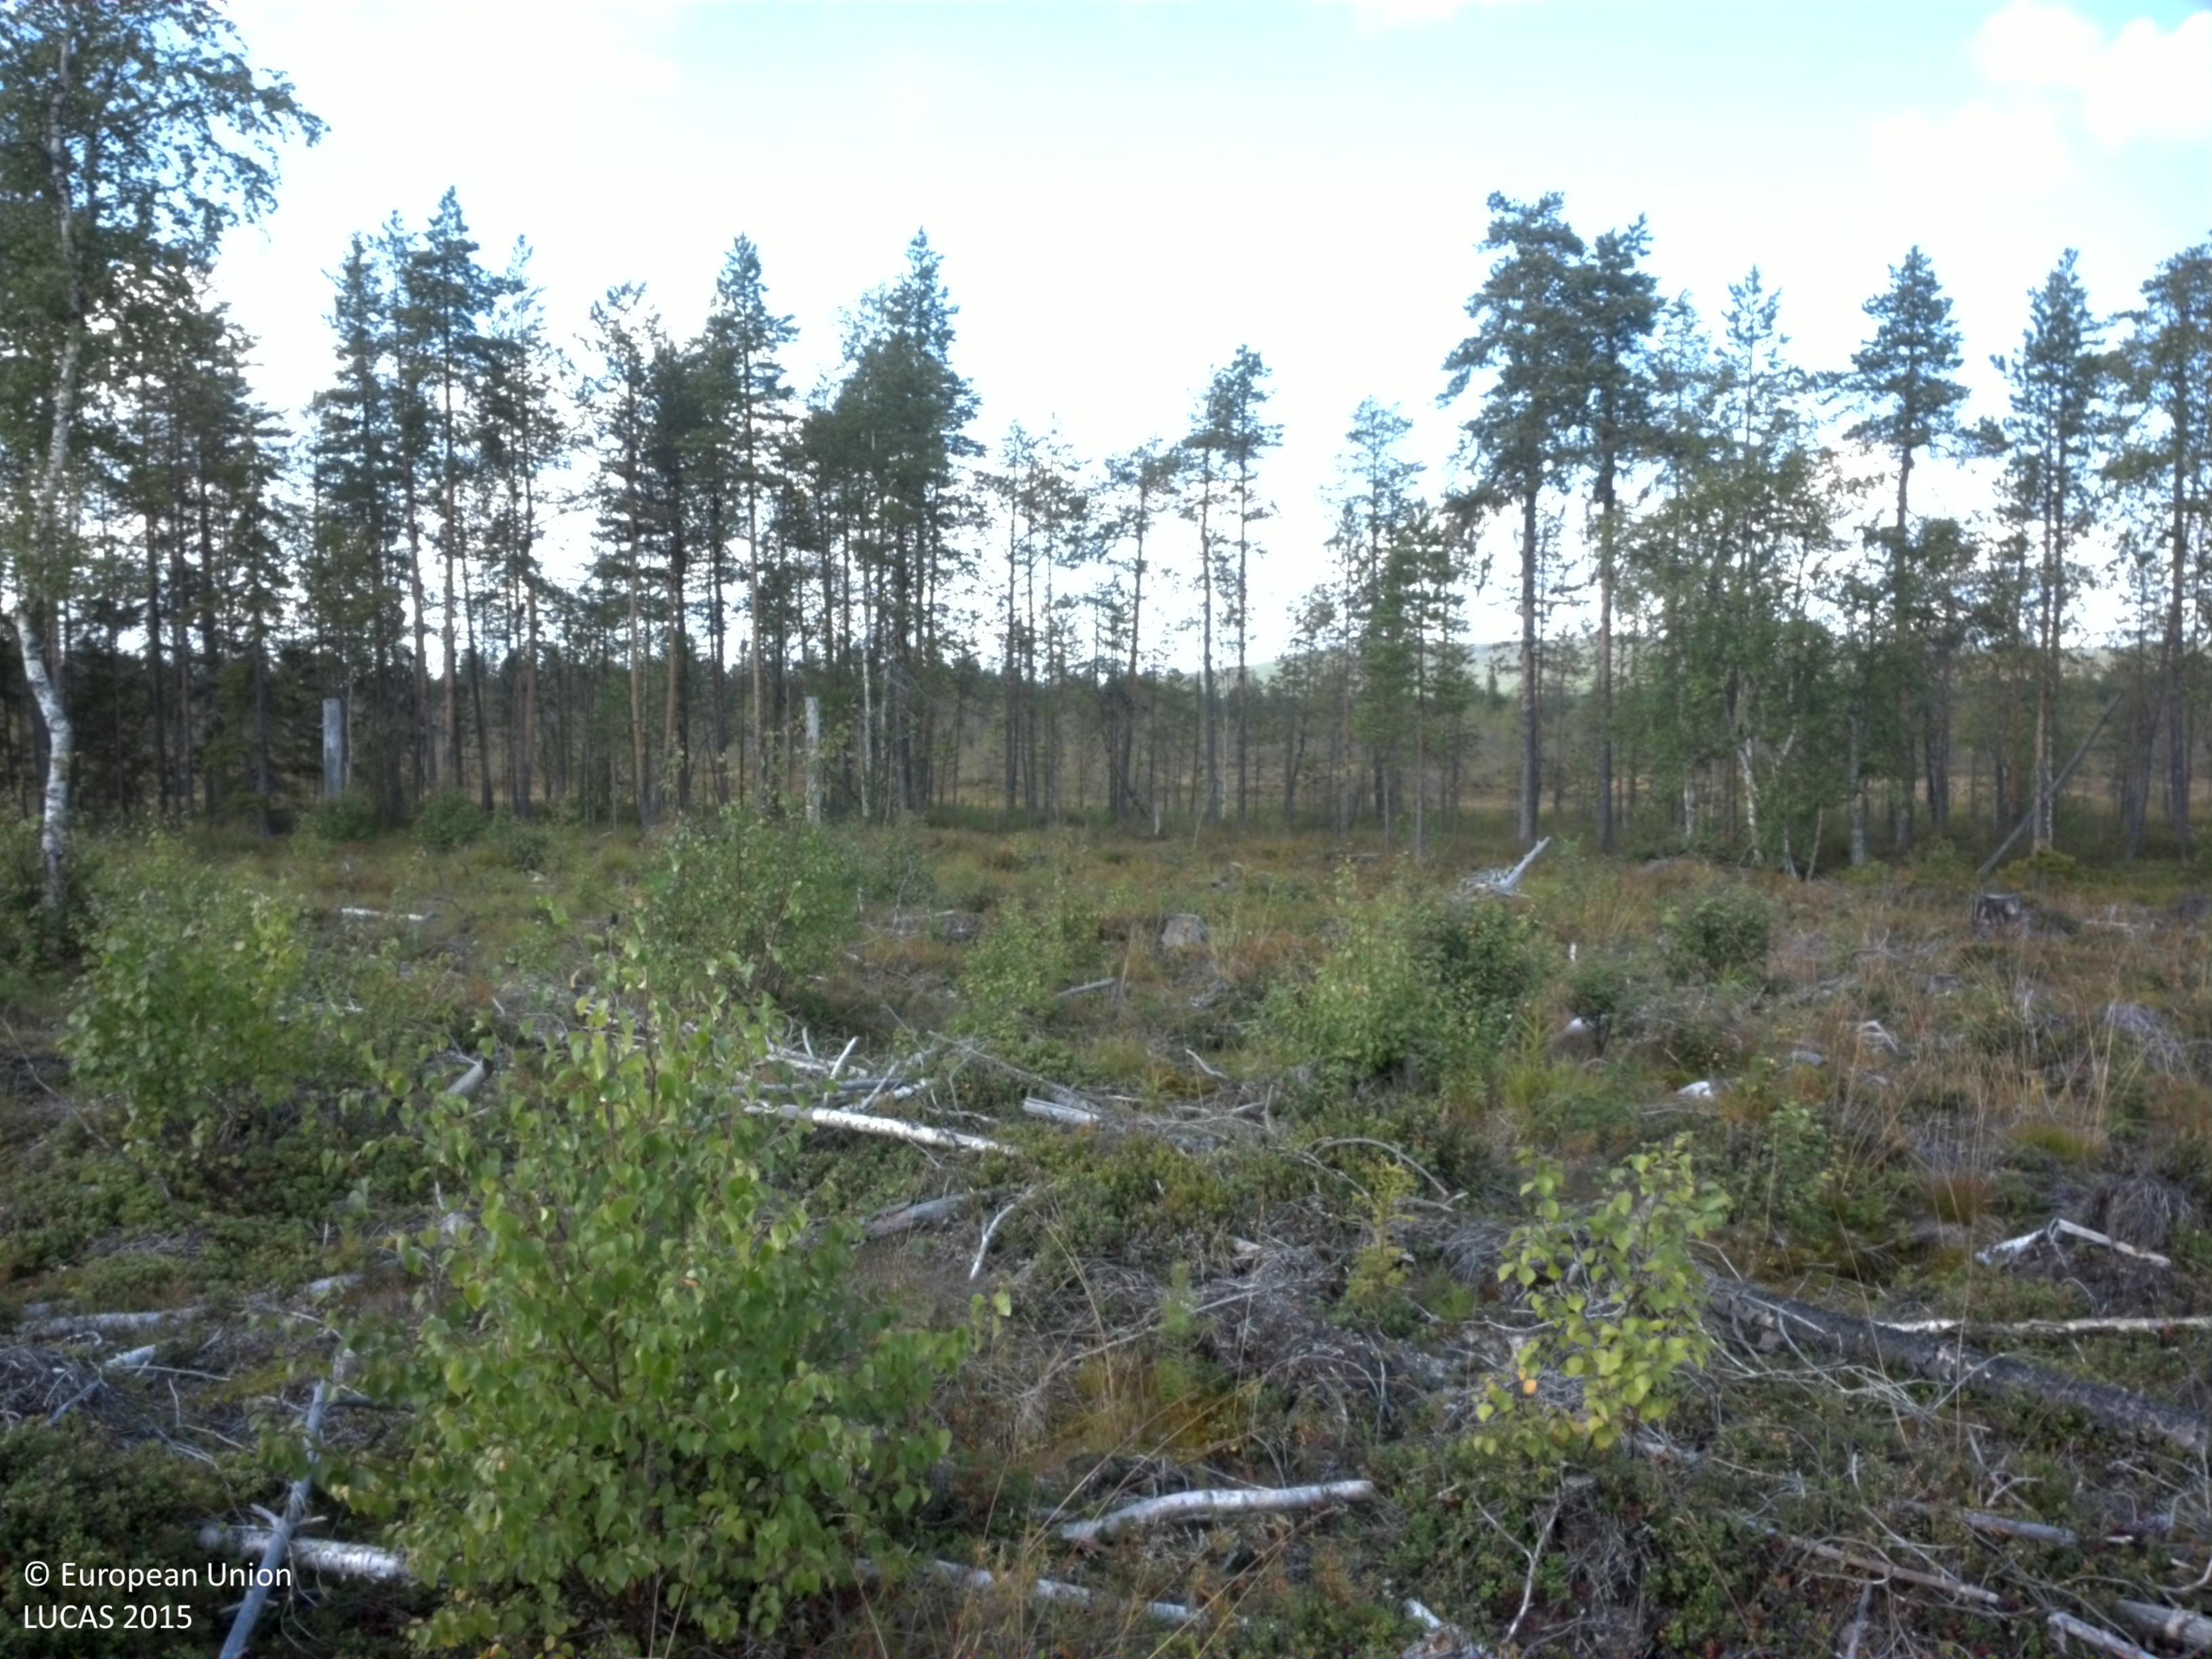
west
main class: Shrubland
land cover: Shrubland with sparse tree cover
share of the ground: > 75 %
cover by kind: shrubs 80 %, lichens and mosses 10 %, broadleaved forest trees 5 %, herbaceous plants 5 %
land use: Forestry
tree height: < 5 m
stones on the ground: 10 - 25 %
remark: Clear cut
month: August
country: SE
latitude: 64.5606
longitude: 19.0036
